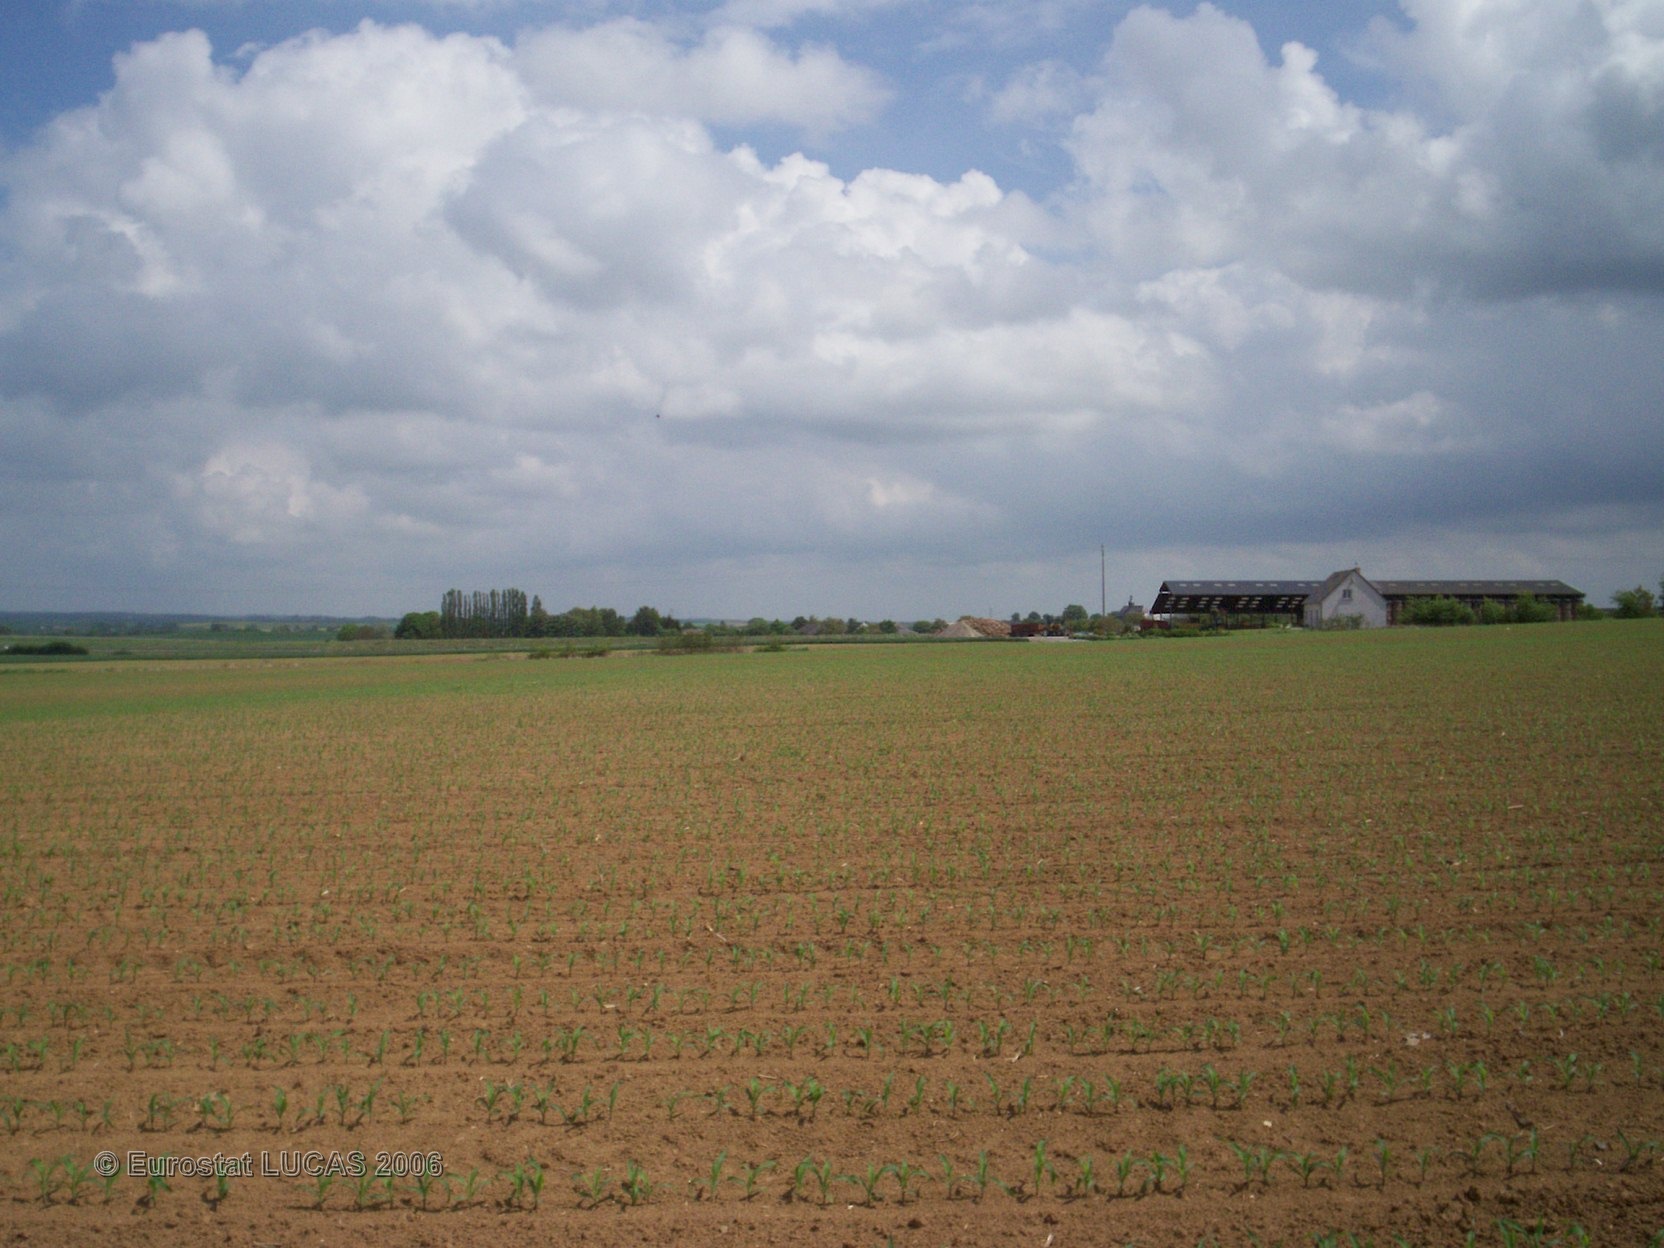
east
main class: Cropland
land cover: Maize
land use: Agriculture (excluding fallow land and kitchen gardens)
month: May
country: FR
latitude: 49.5432
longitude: 4.4265
